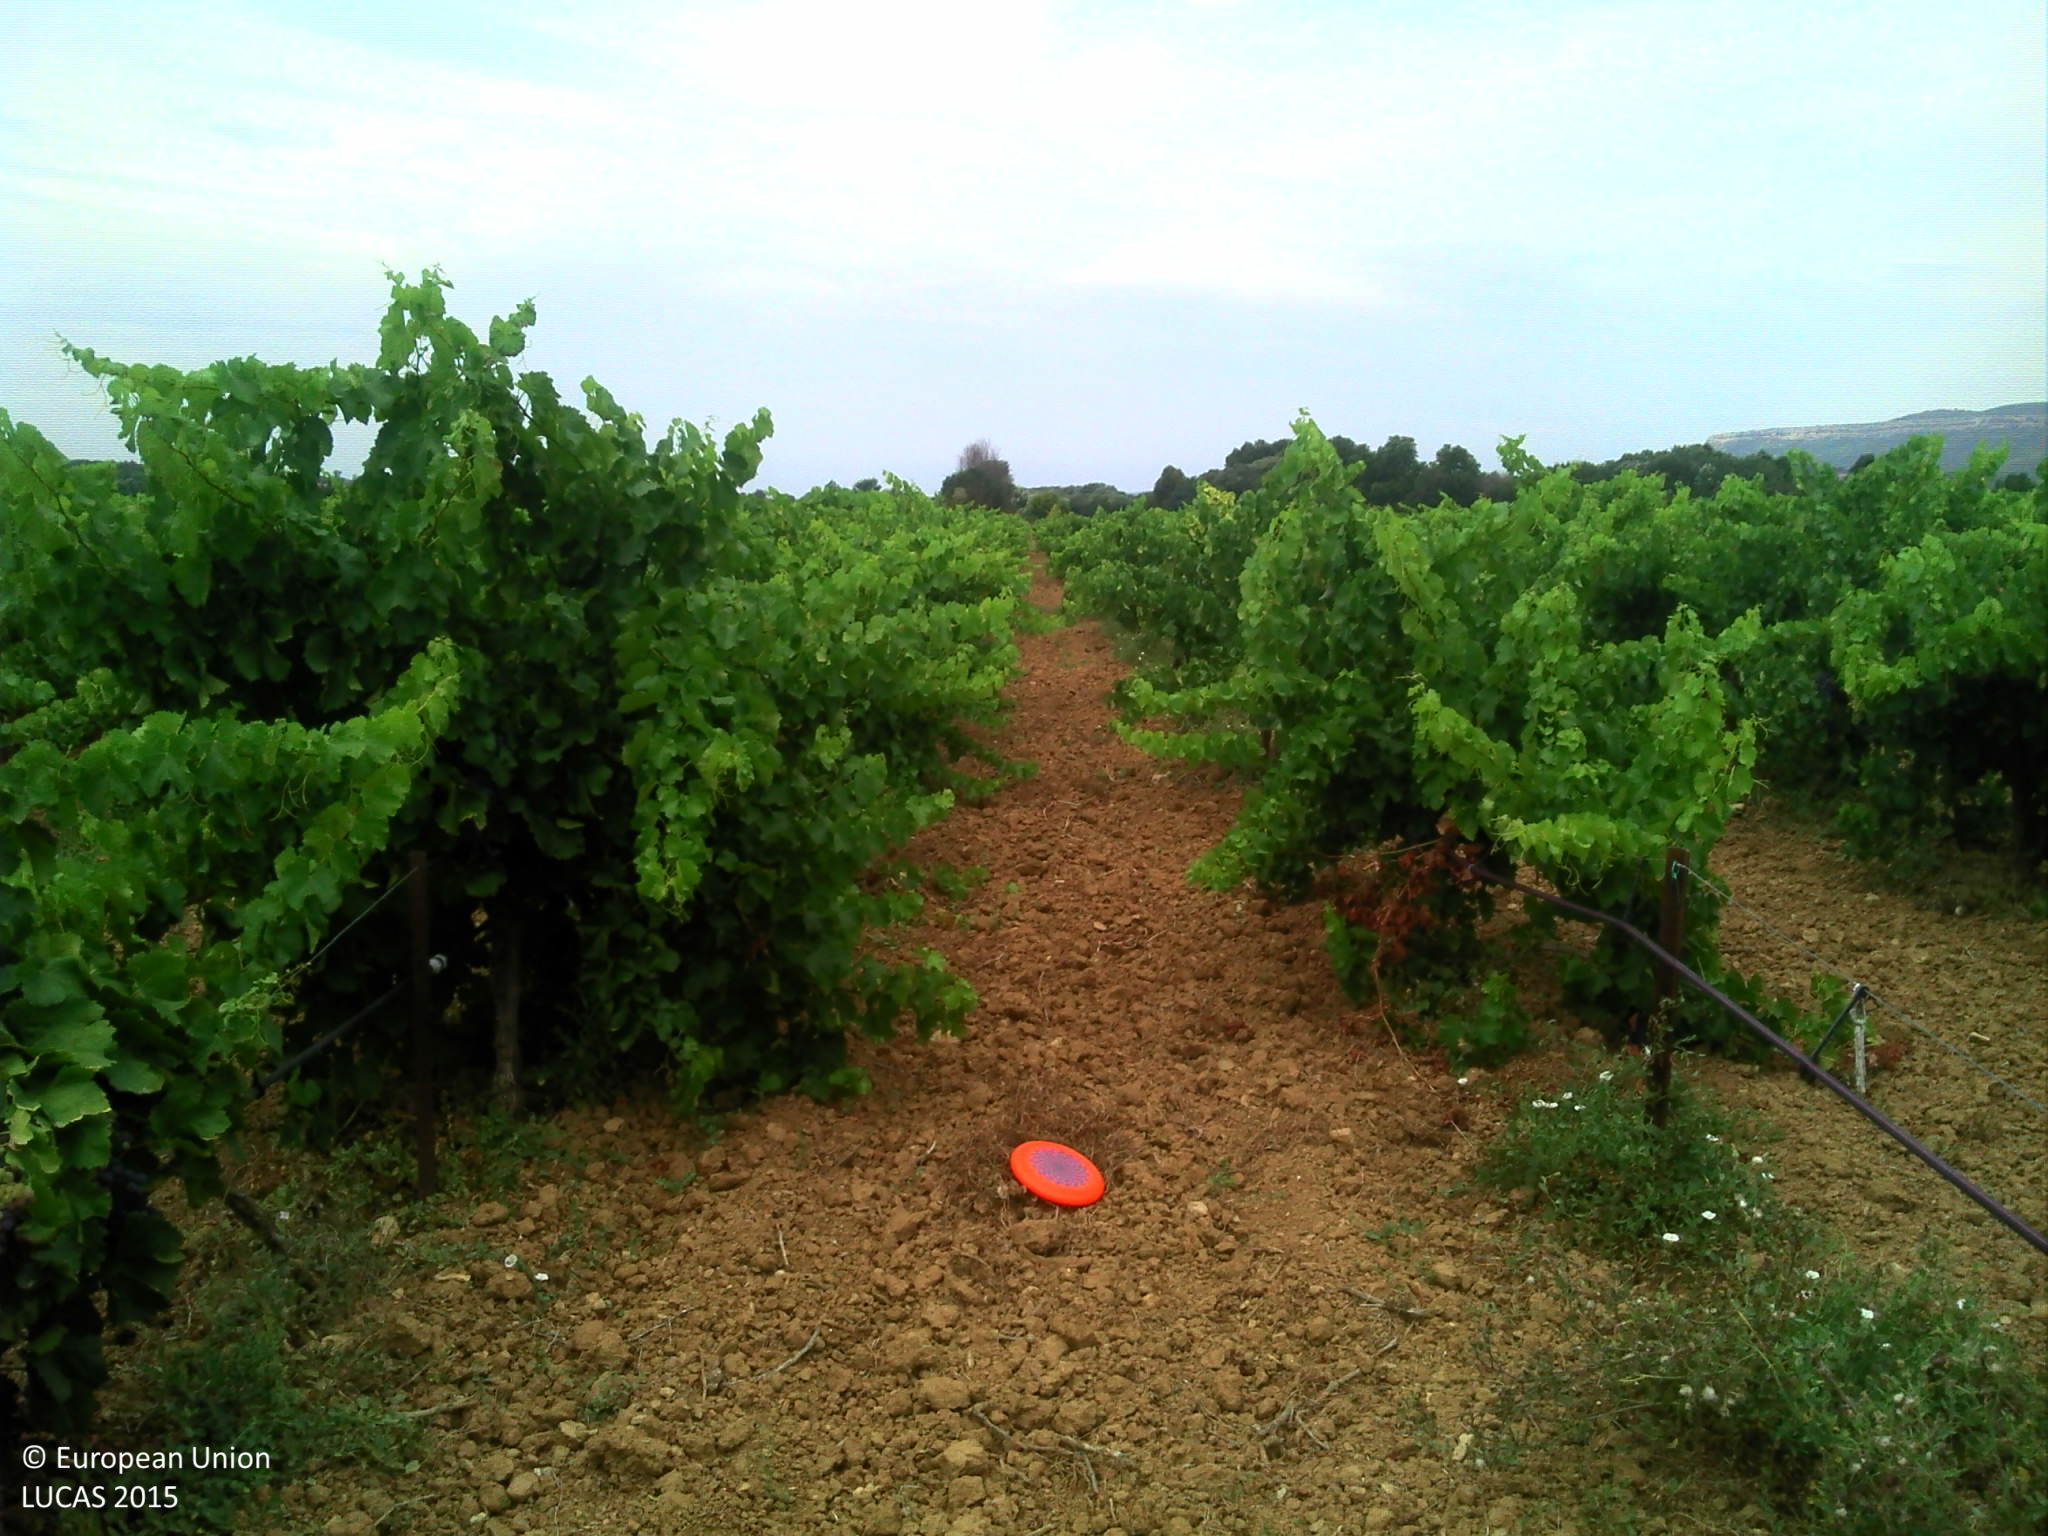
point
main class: Cropland
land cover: Vineyards
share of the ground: > 75 %
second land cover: Other bare soil
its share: > 75 %
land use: Agriculture (excluding fallow land and kitchen gardens)
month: August
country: FR
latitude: 43.4643
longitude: 5.6465
